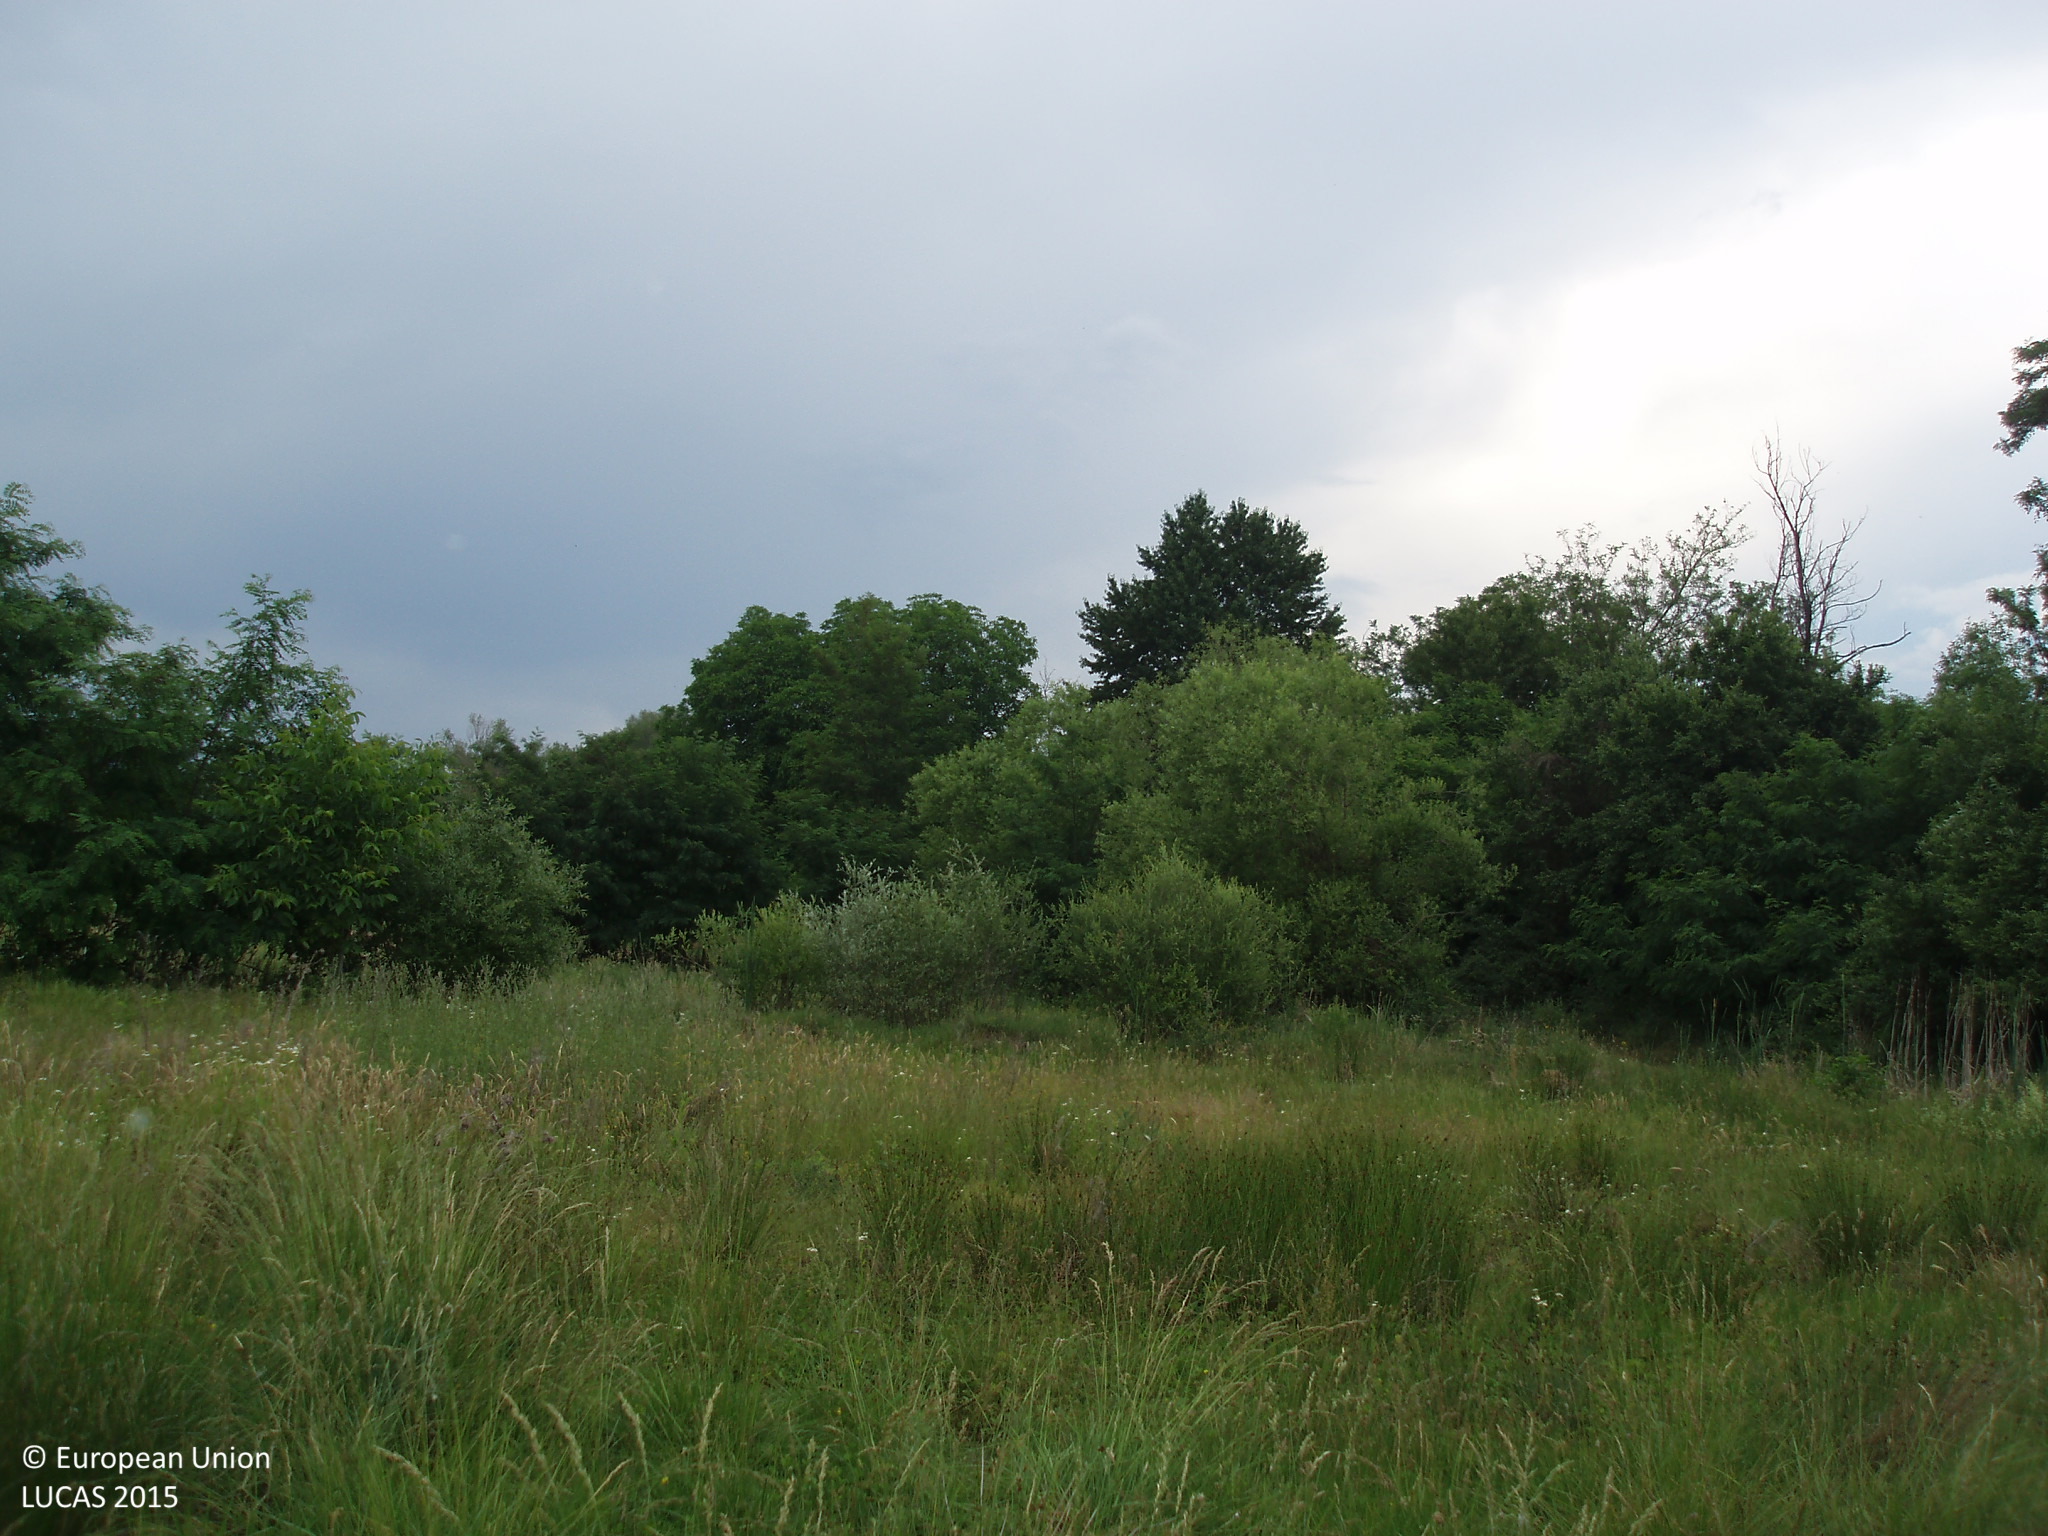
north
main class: Grassland
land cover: Grassland without tree/shrub cover
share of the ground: > 75 %
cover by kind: herbaceous plants 100 %
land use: Agriculture (excluding fallow land and kitchen gardens)
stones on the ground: 10 - 25 %
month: June
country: BG
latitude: 41.6202
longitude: 23.7469
